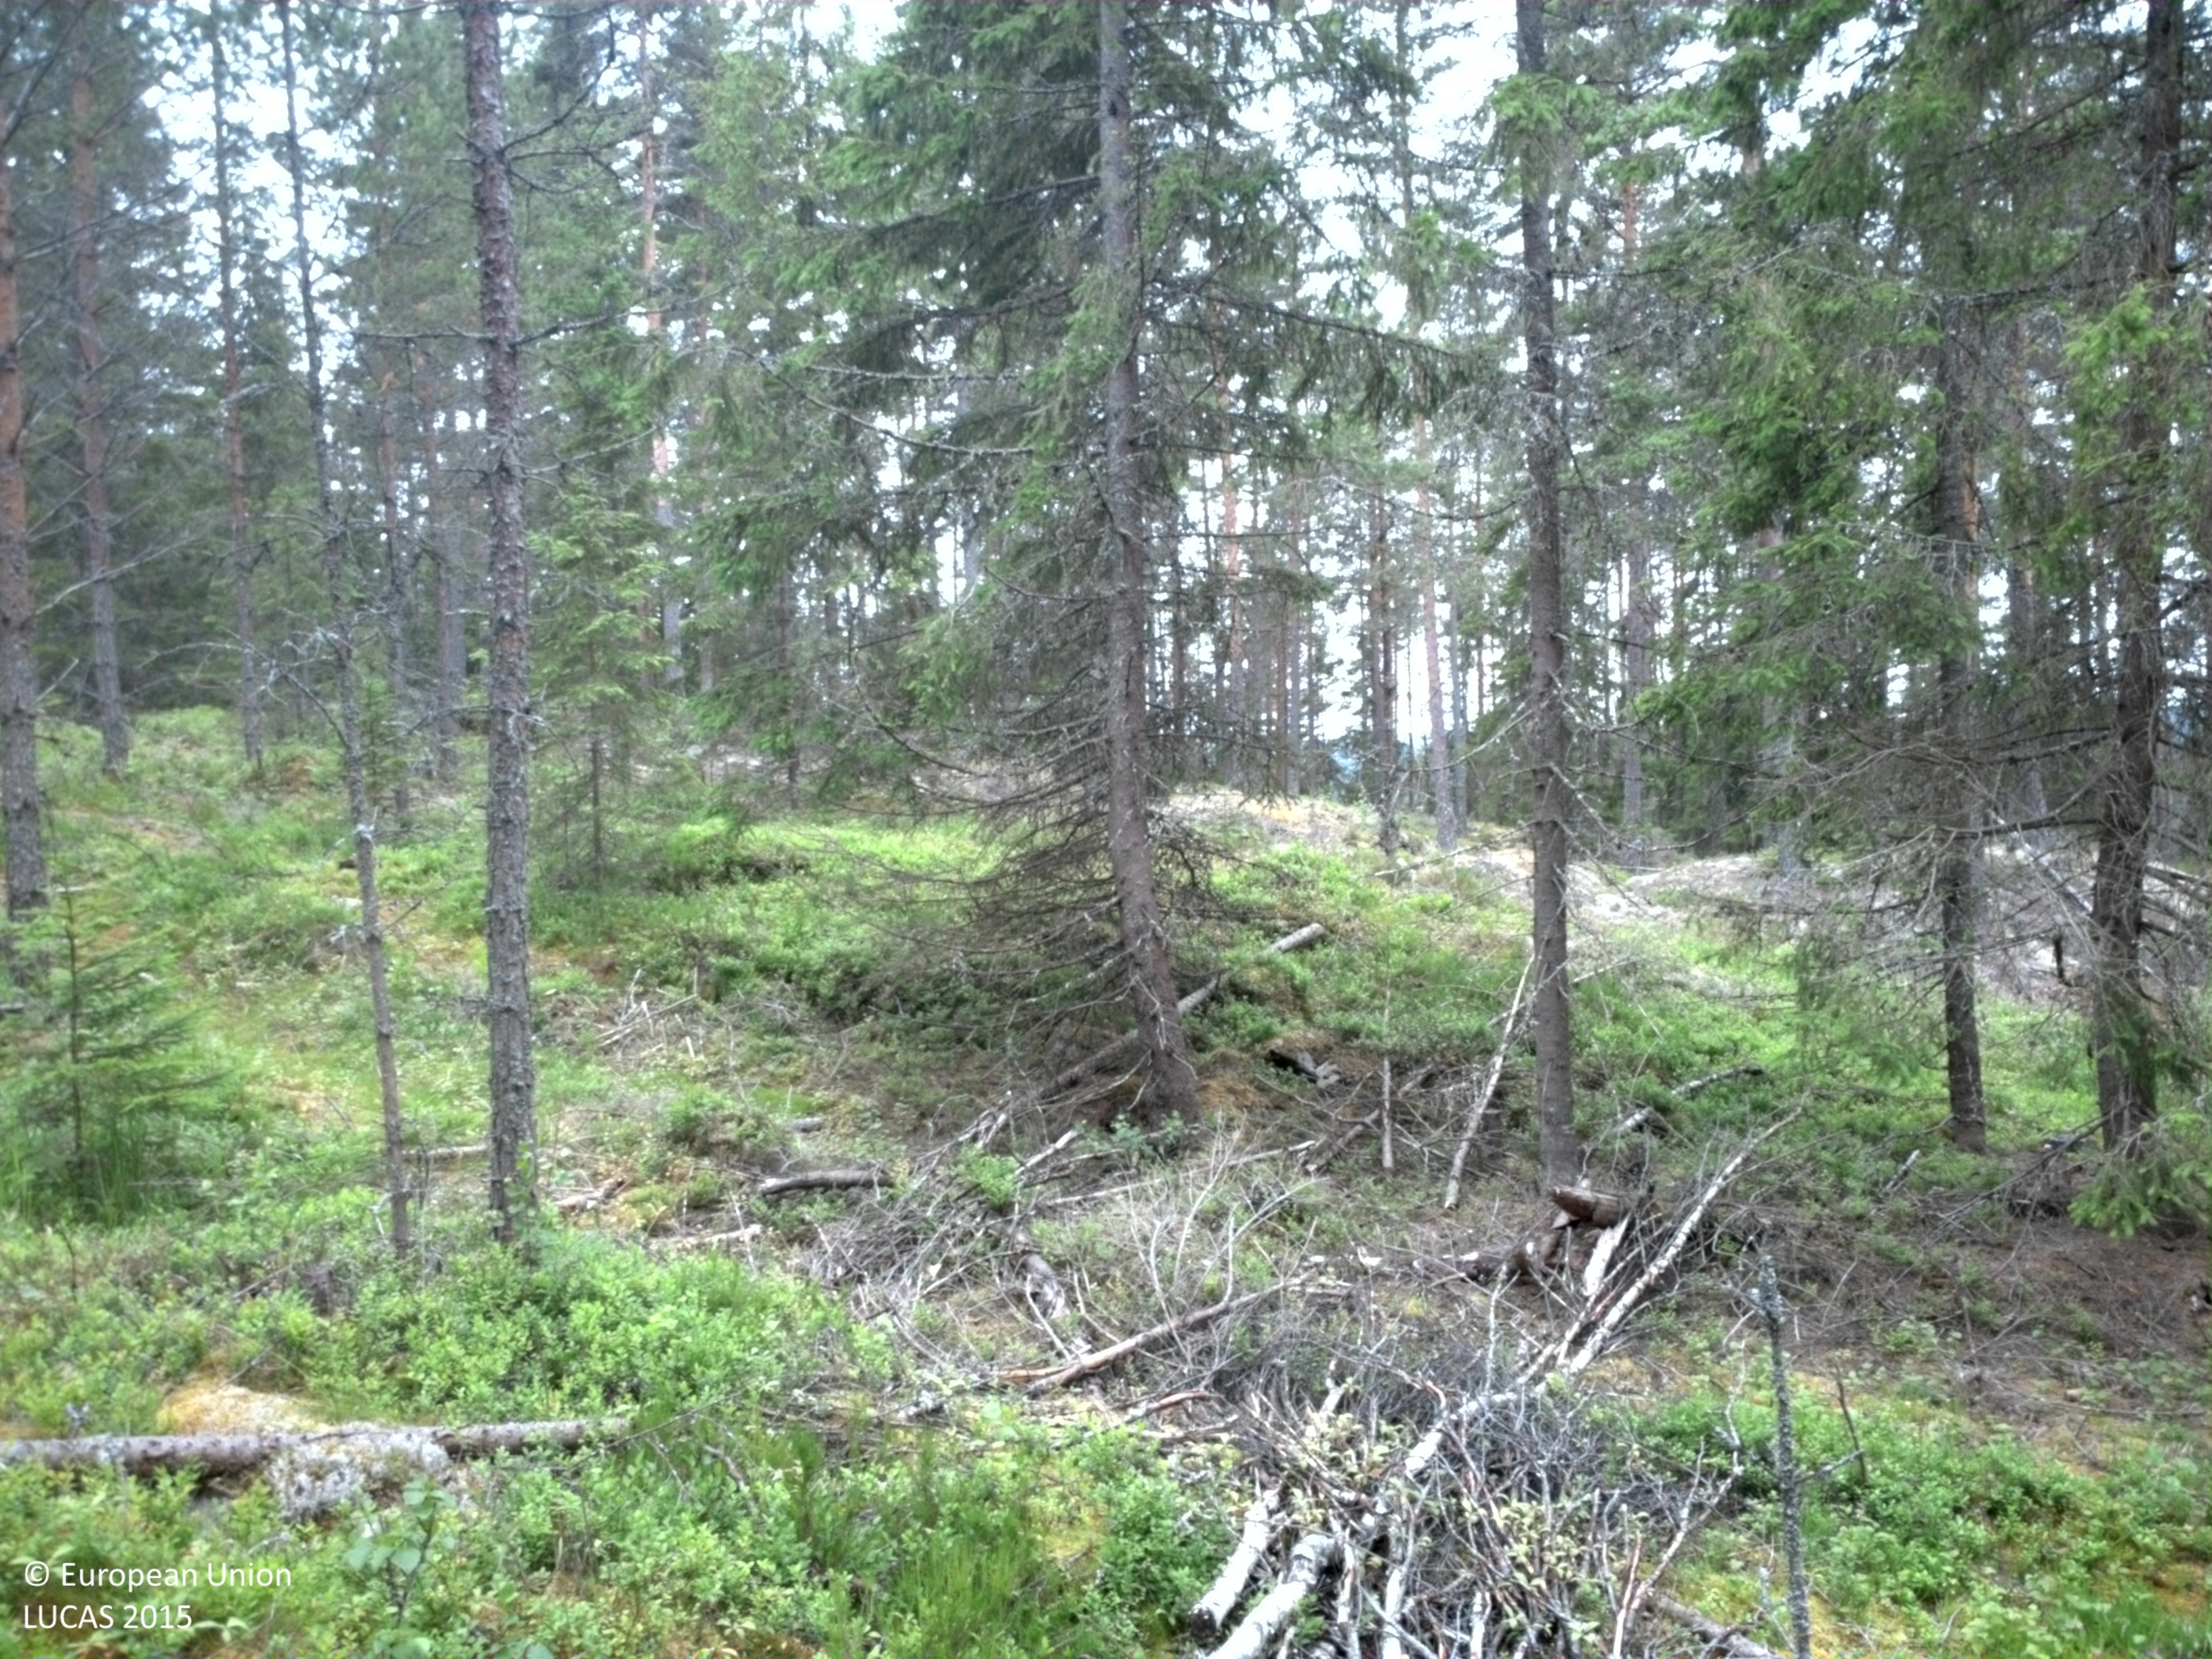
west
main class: Woodland
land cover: Pine dominated mixed woodland
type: boreal forest
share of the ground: 25 - 50 %
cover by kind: coniferous forest trees 35 %, shrubs 25 %, lichens and mosses 20 %, broadleaved forest trees 15 %, herbaceous plants 5 %
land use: Forestry
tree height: > 5 m
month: July
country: SE
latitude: 59.6453
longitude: 11.9284
